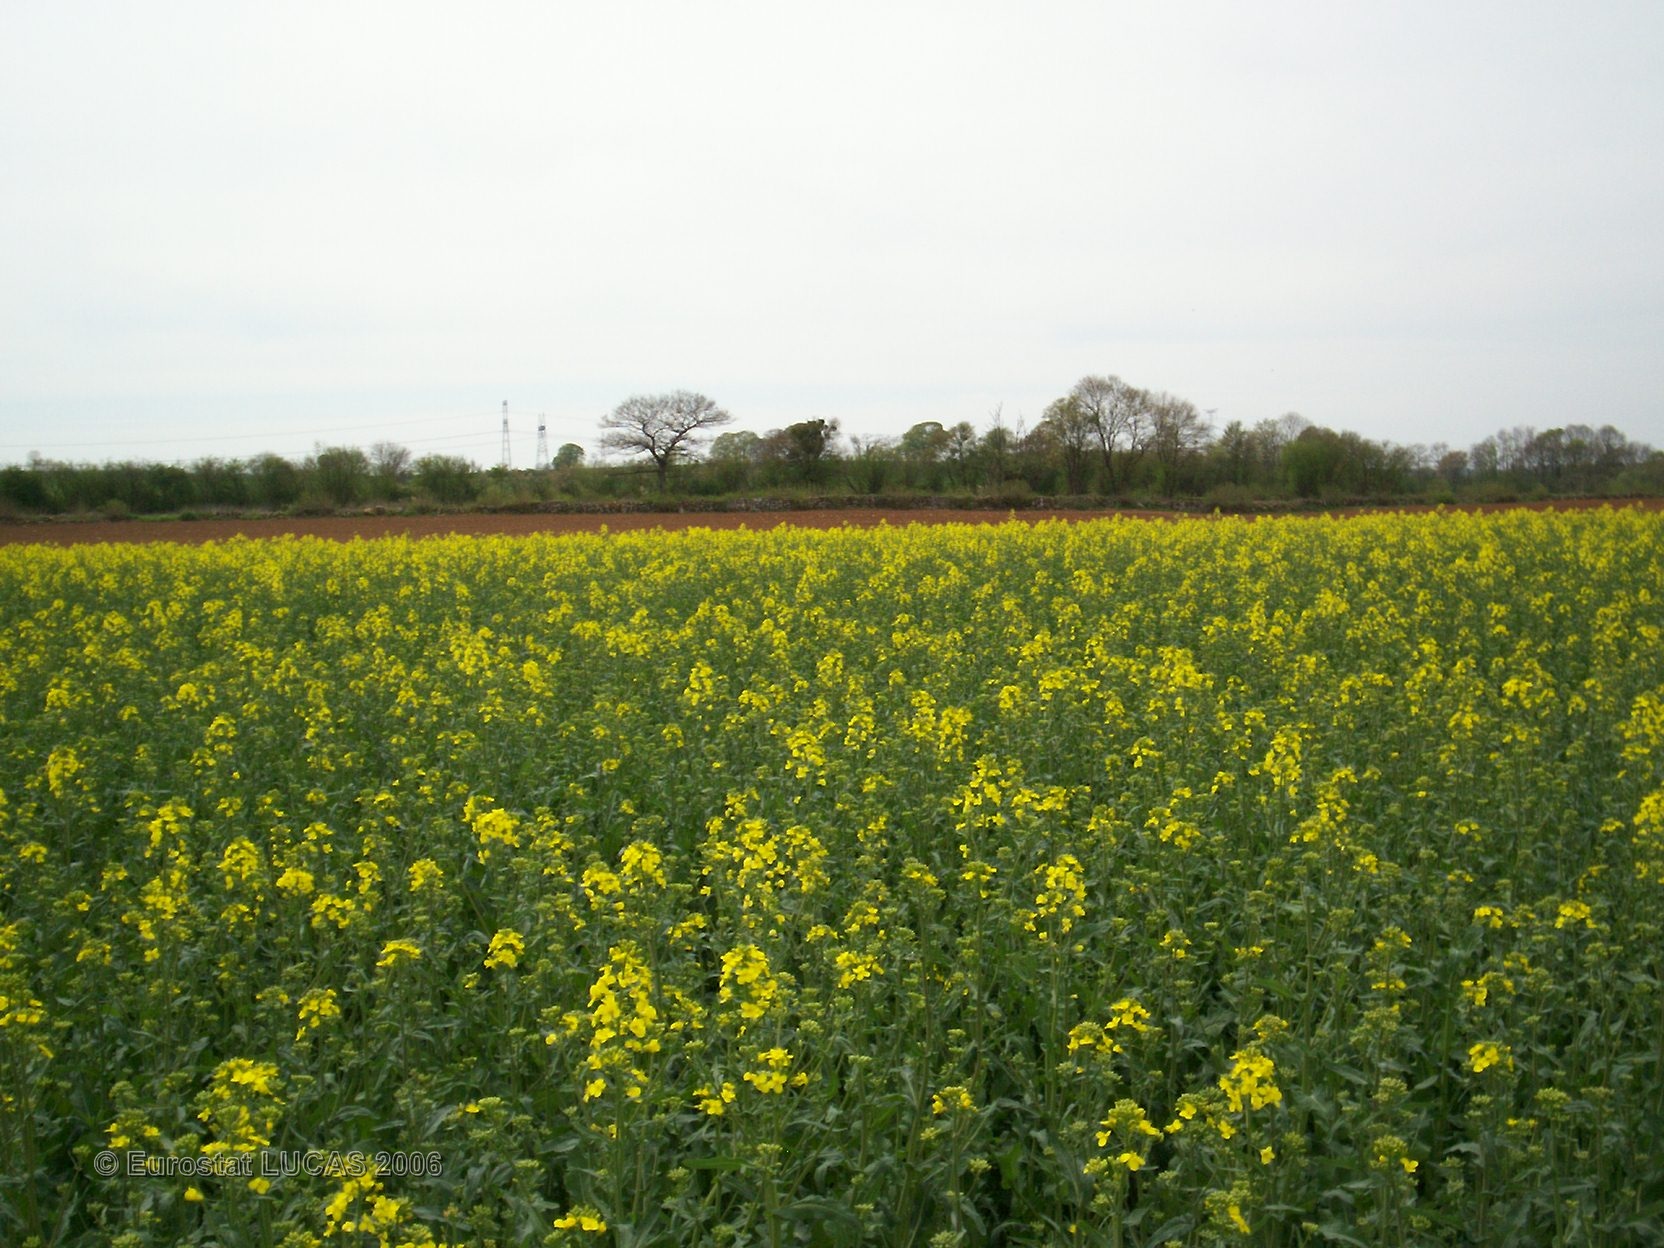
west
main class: Cropland
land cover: Rape and turnip rape
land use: Agriculture (excluding fallow land and kitchen gardens)
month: May
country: FR
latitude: 47.6906
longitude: 4.5228
